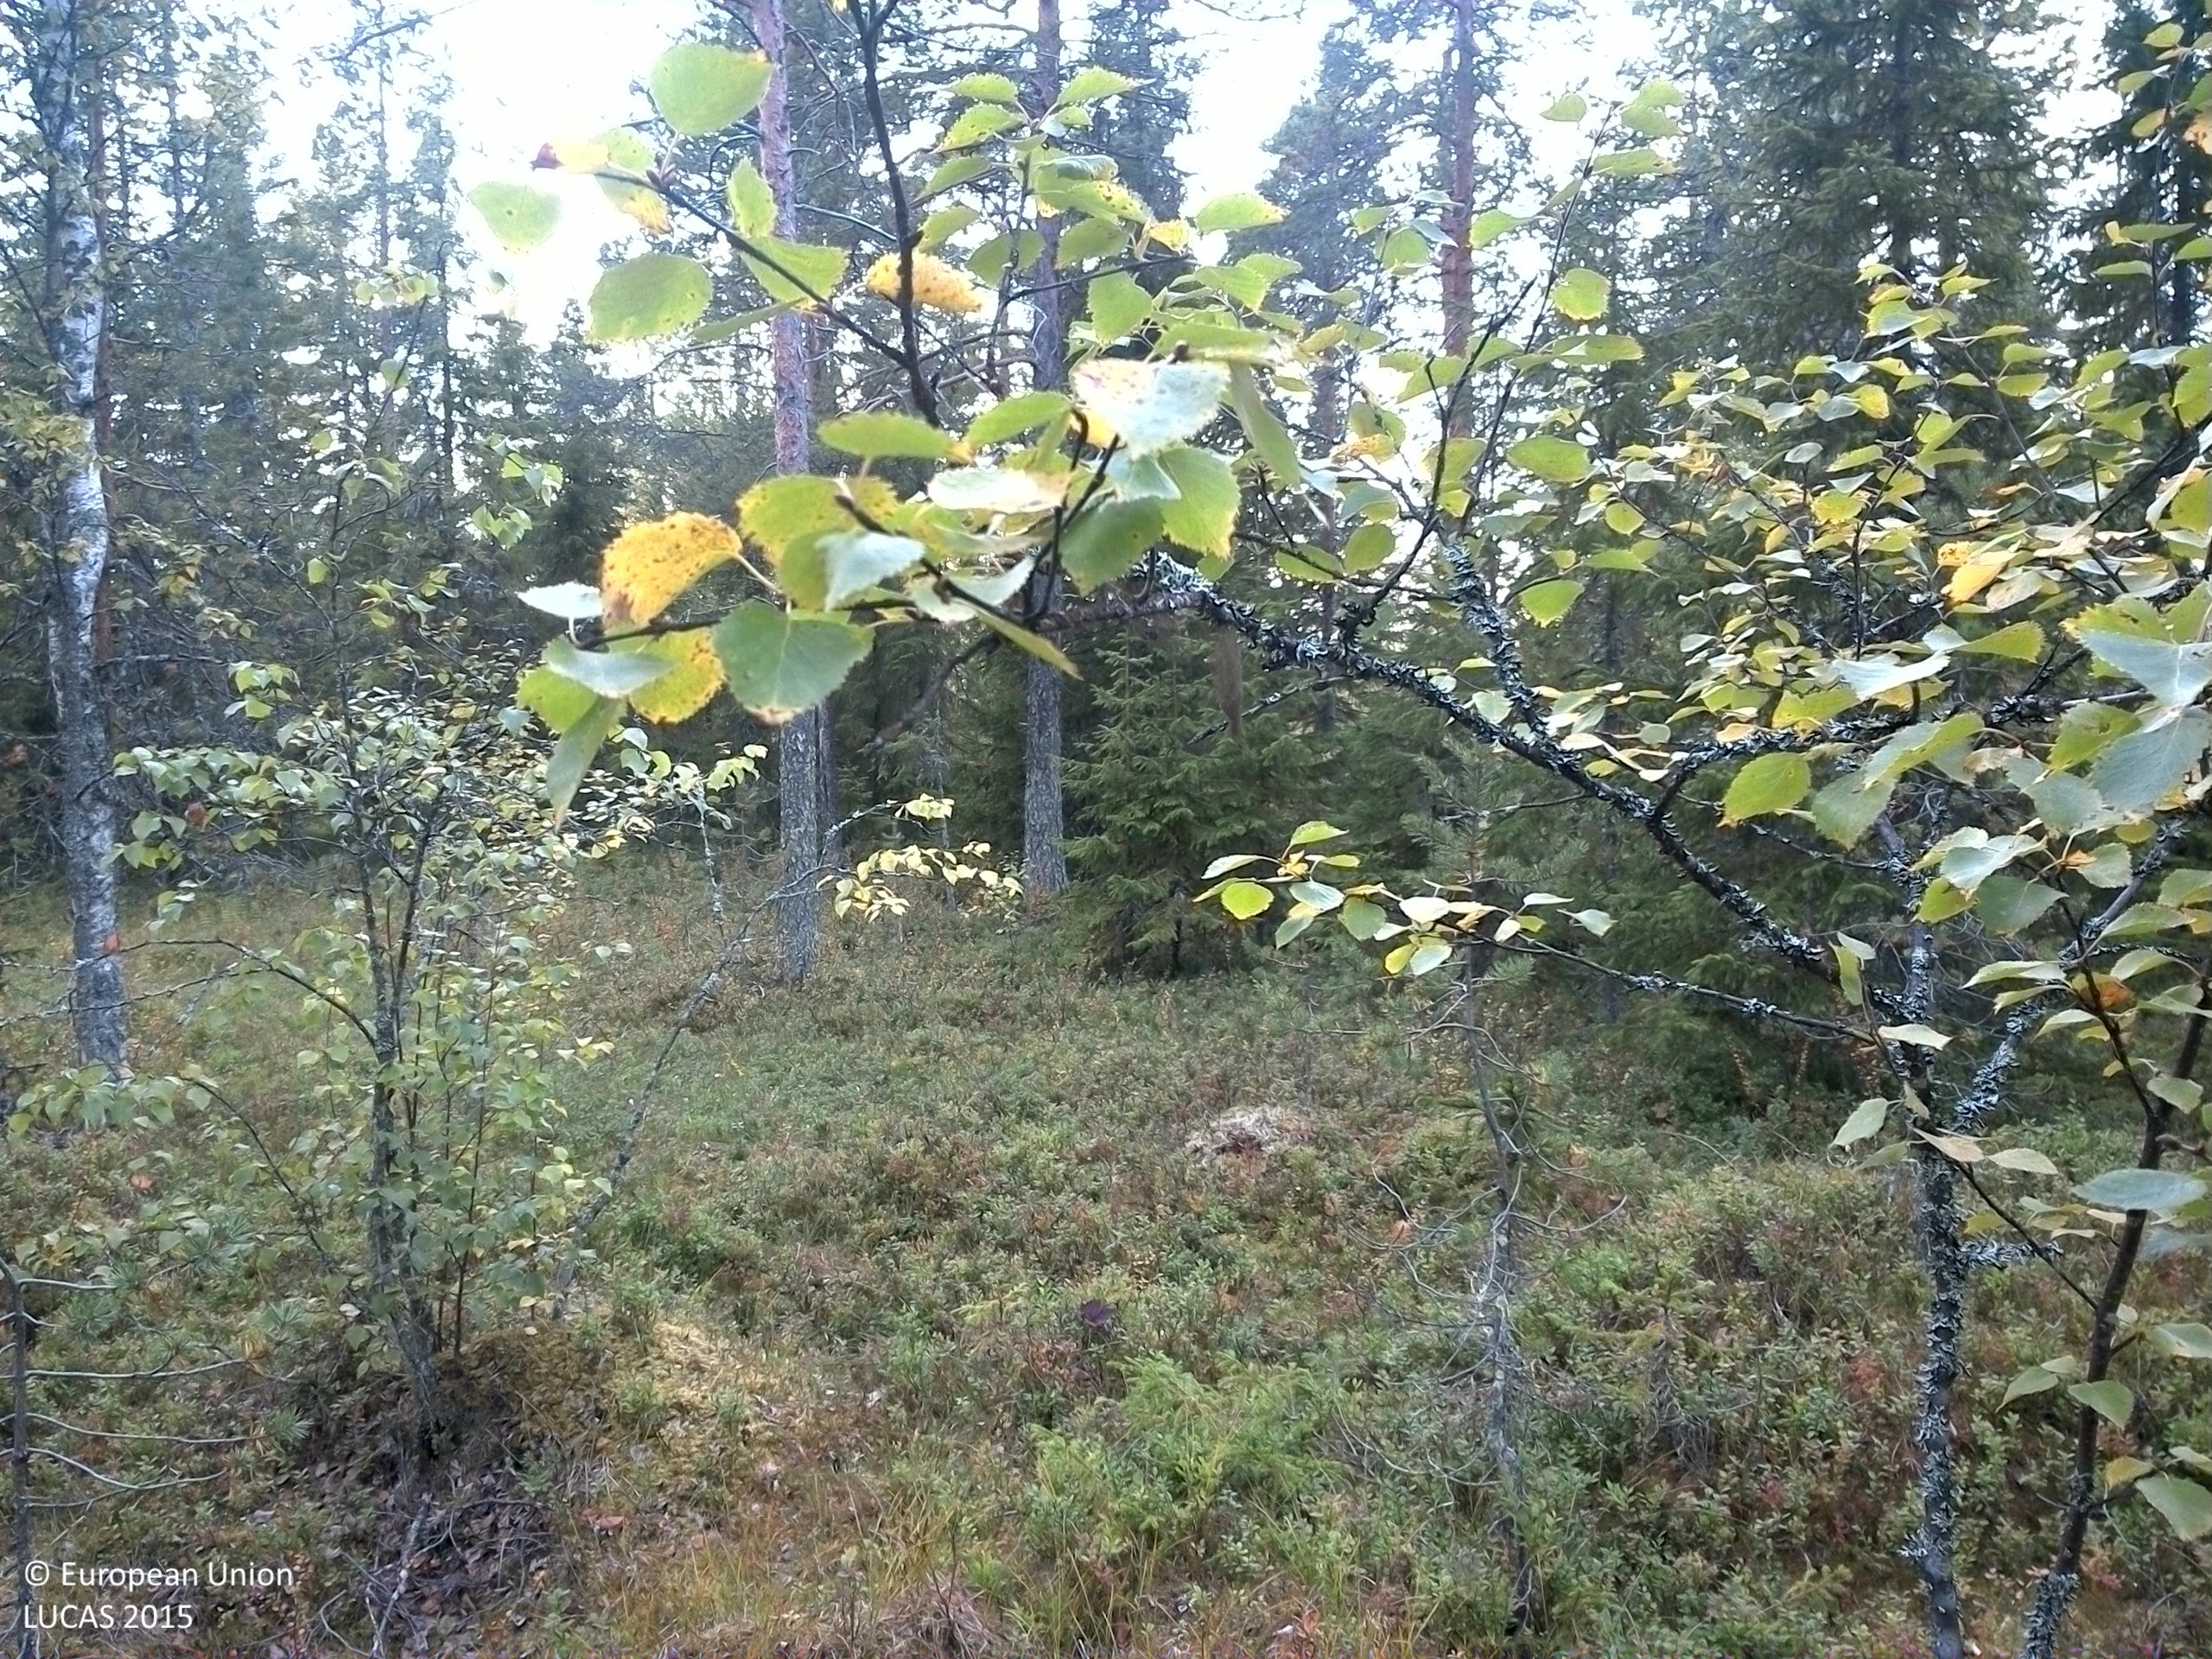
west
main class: Woodland
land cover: Pine dominated mixed woodland
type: boreal forest
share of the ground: 25 - 50 %
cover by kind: shrubs 55 %, coniferous forest trees 25 %, broadleaved forest trees 10 %, lichens and mosses 10 %
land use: Forestry
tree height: > 5 m
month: September
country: SE
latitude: 64.0602
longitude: 16.6296
